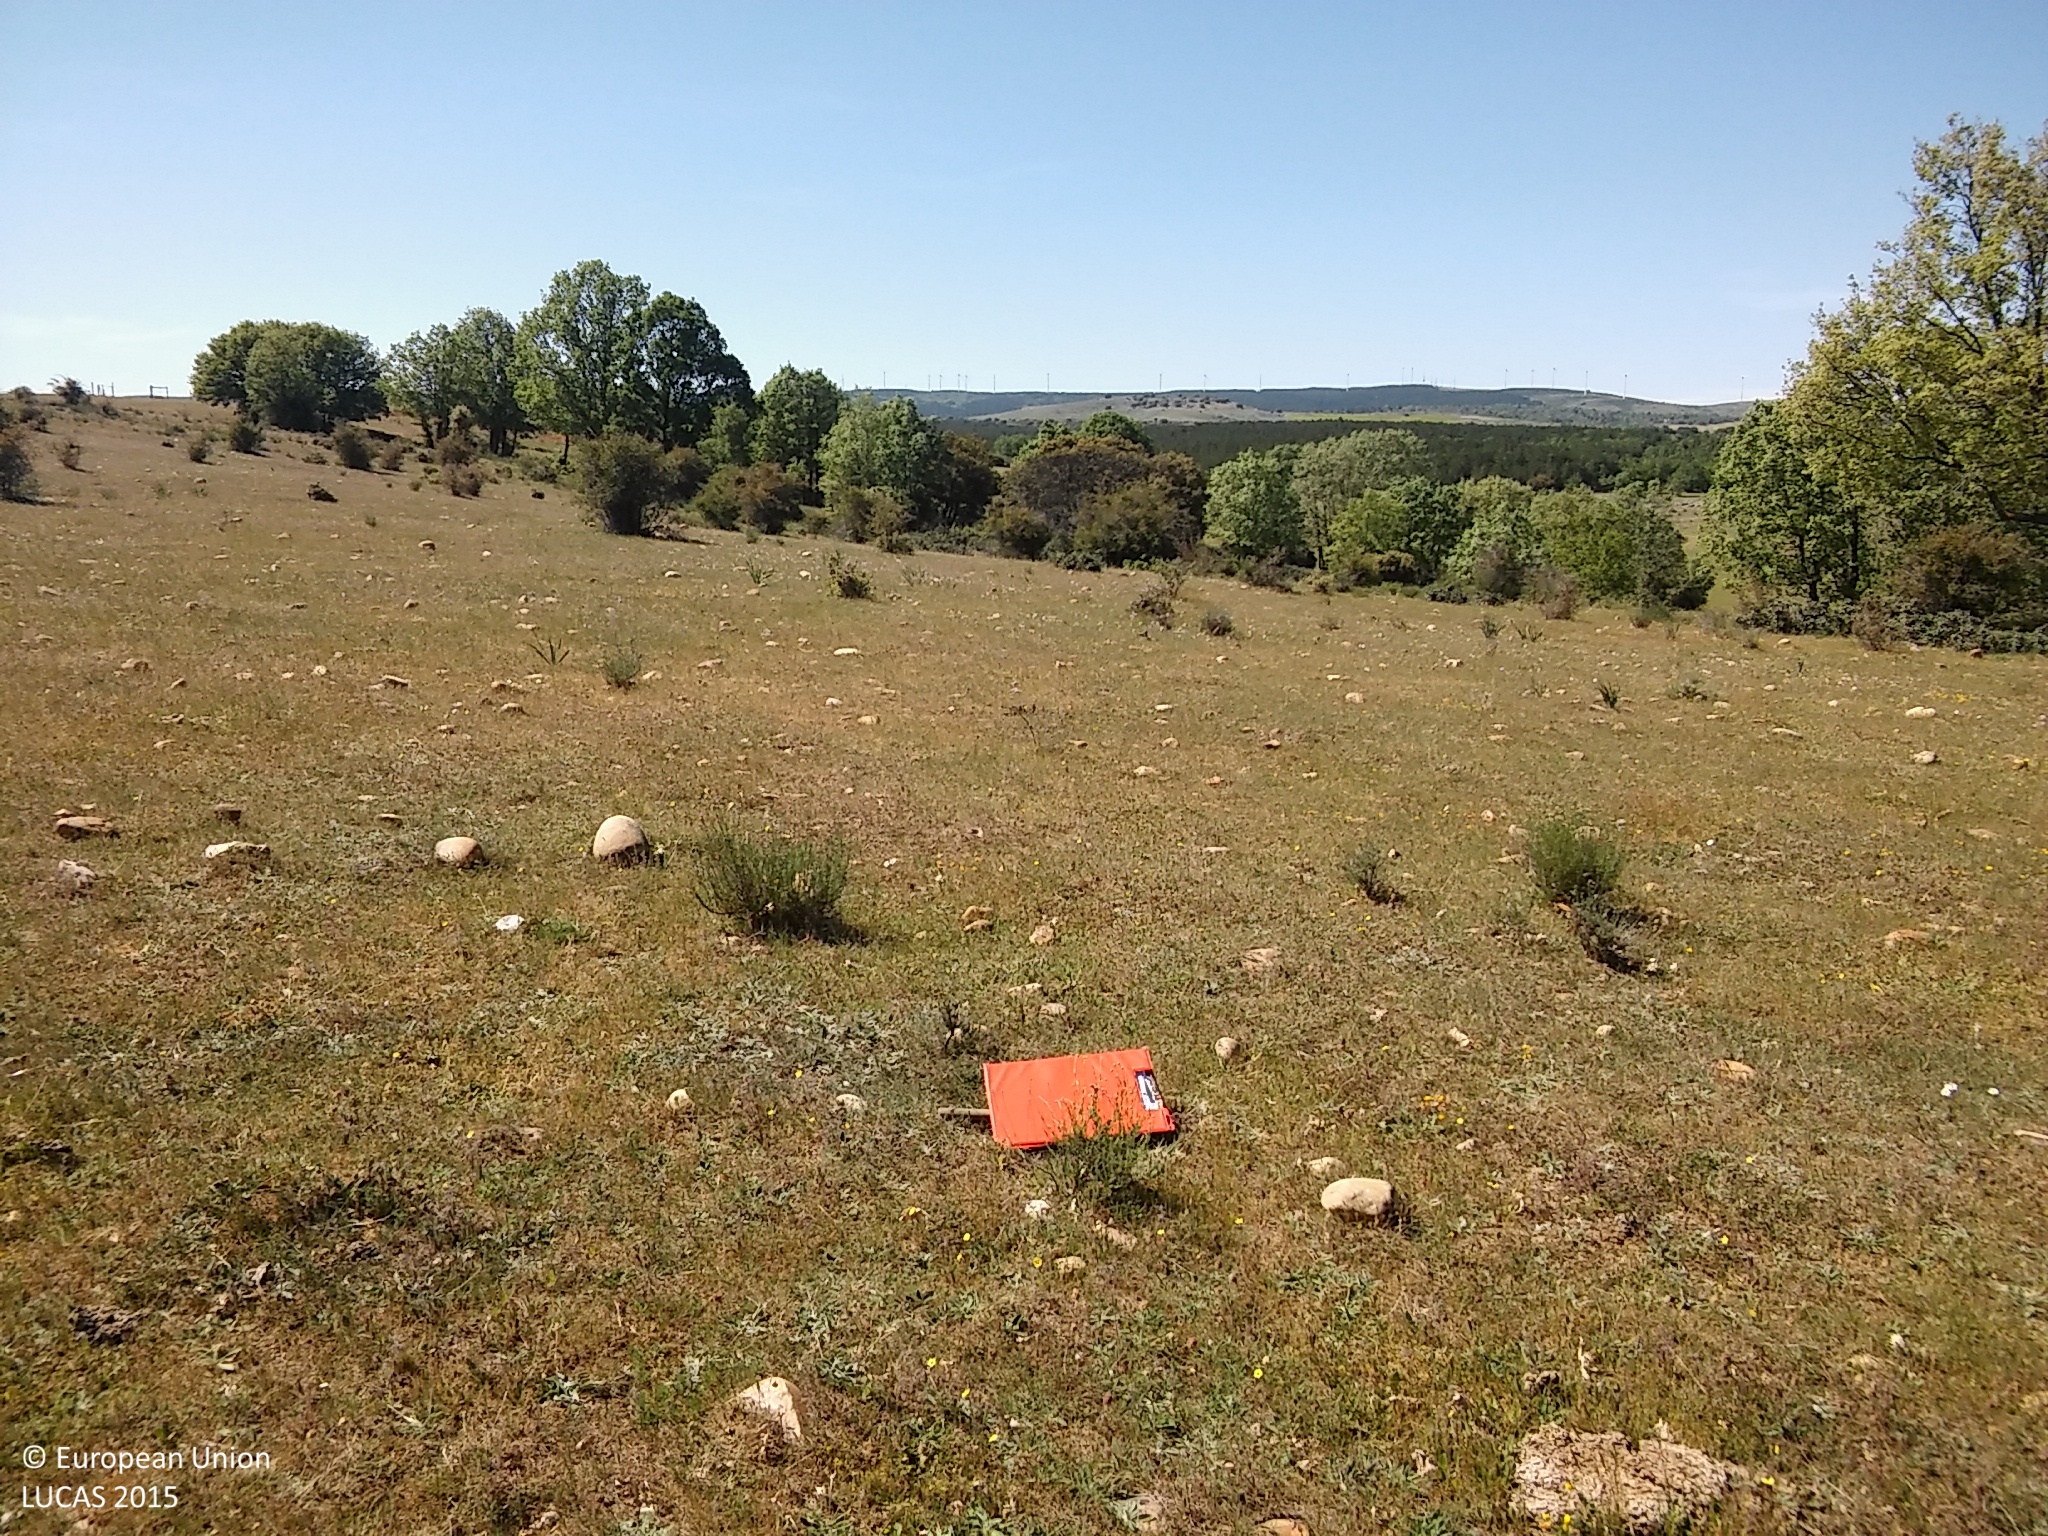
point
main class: Grassland
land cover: Grassland without tree/shrub cover
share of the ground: > 75 %
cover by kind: herbaceous plants 95 %, shrubs 5 %
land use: Agriculture (excluding fallow land and kitchen gardens)
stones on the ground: 10 - 25 %
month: May
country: ES
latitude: 41.4073
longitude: -3.6989
